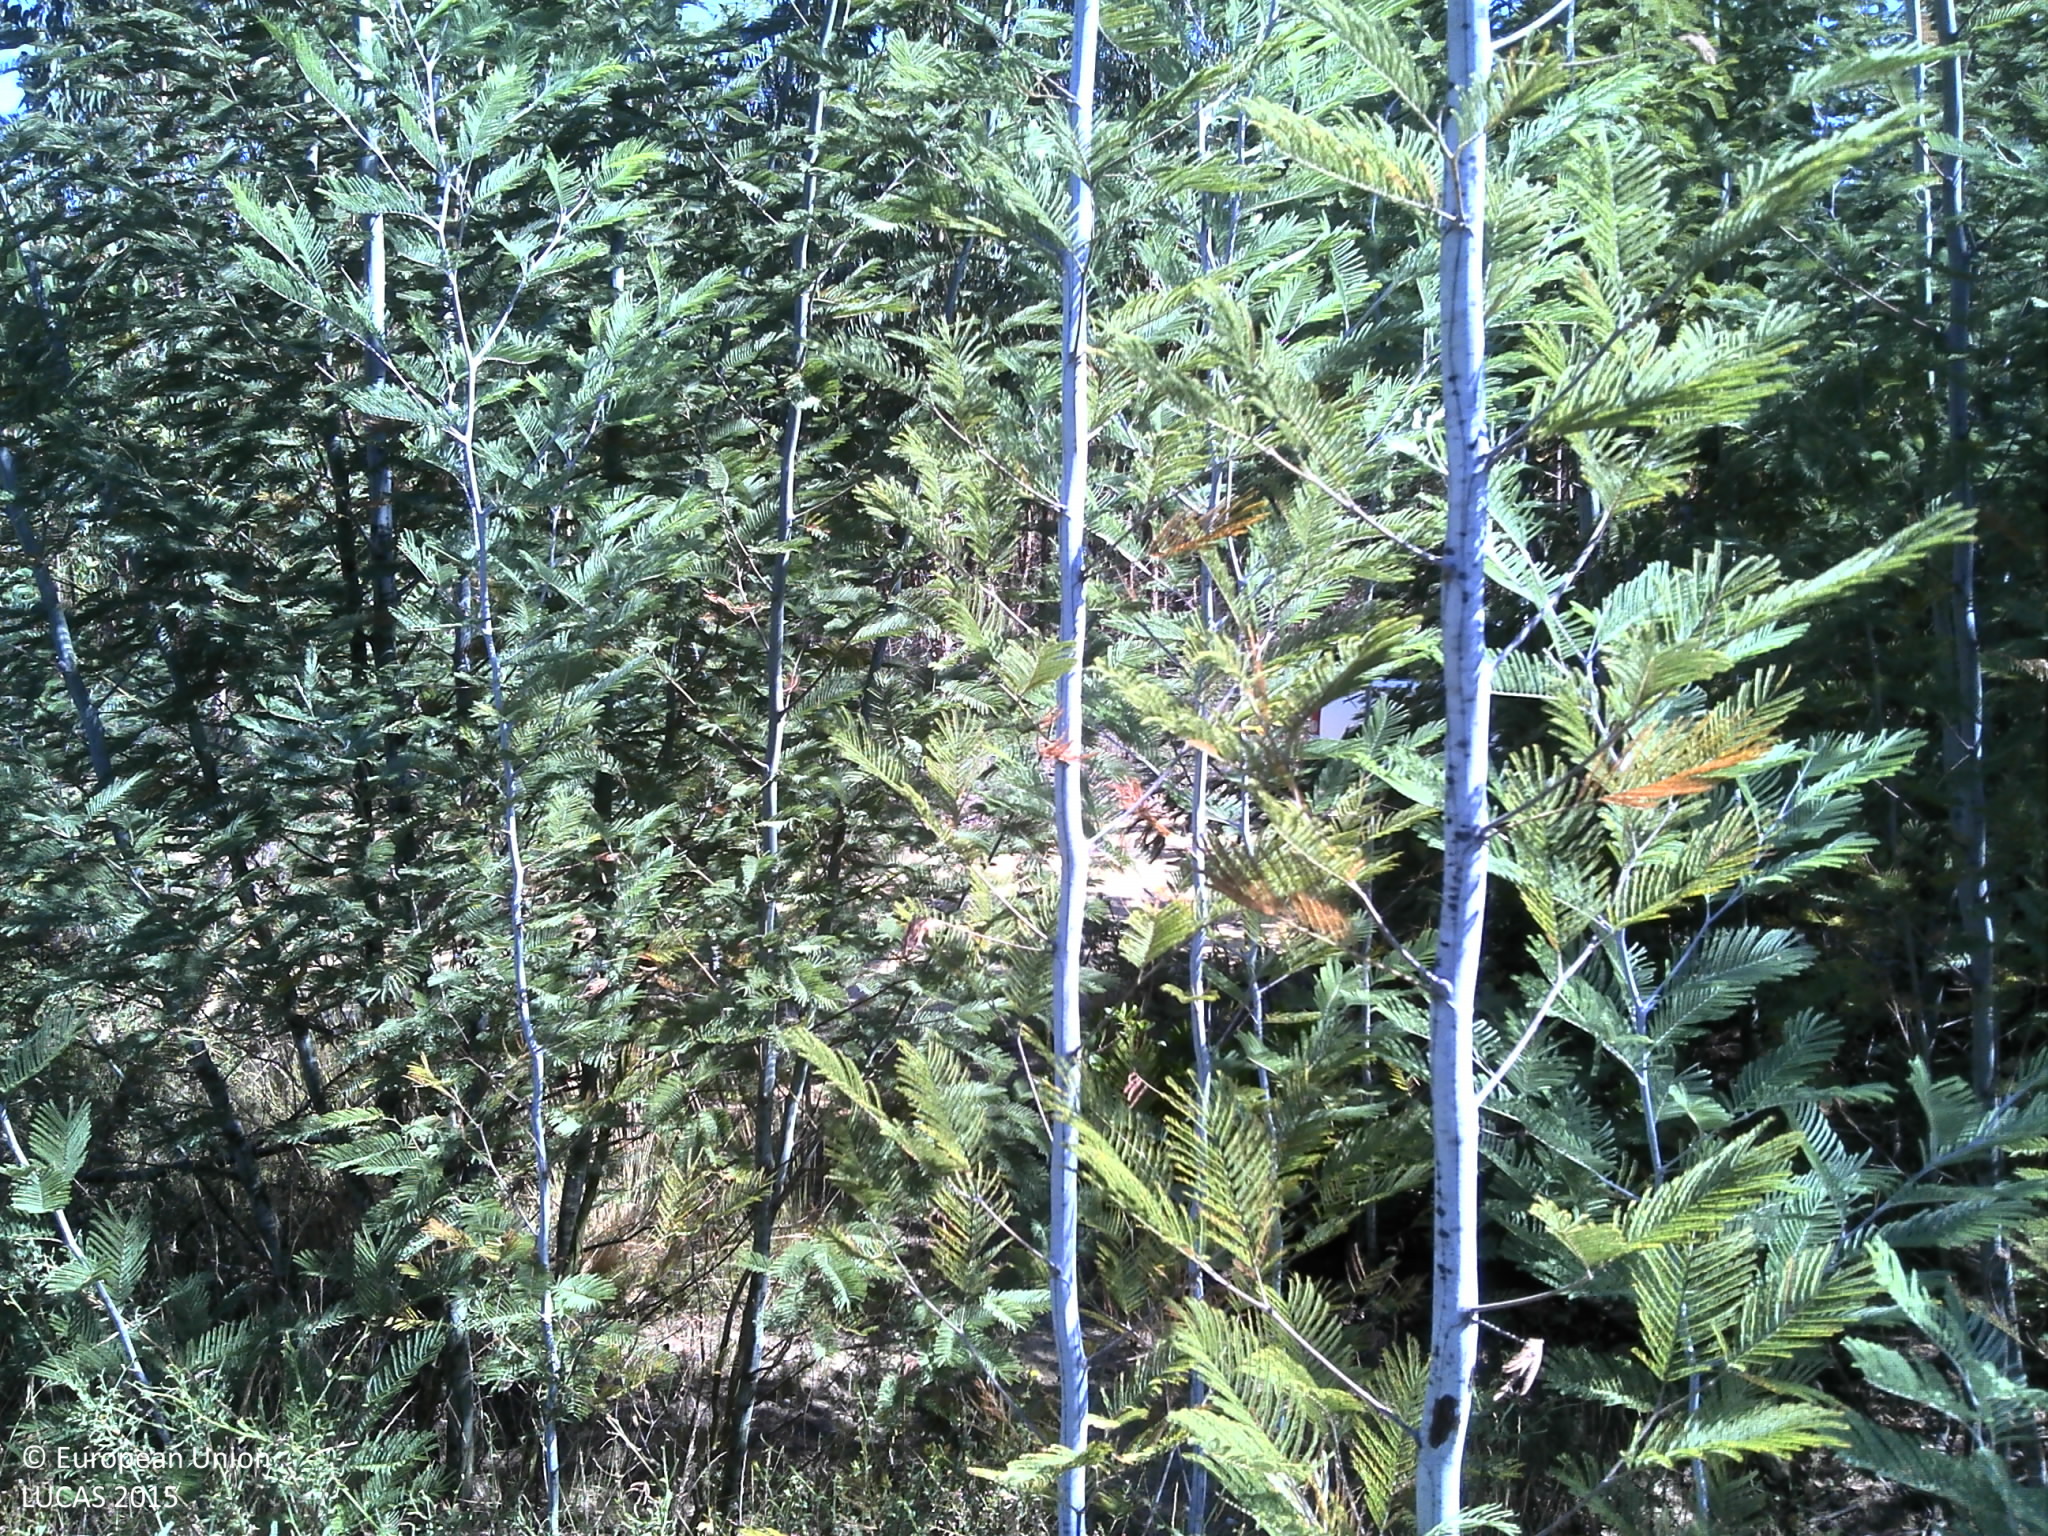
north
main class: Shrubland
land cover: Shrubland with sparse tree cover
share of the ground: > 75 %
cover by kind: shrubs 90 %, broadleaved forest trees 5 %, herbaceous plants 5 %
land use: Semi-natural and natural areas not in use
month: June
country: PT
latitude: 40.1676
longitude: -8.2426
